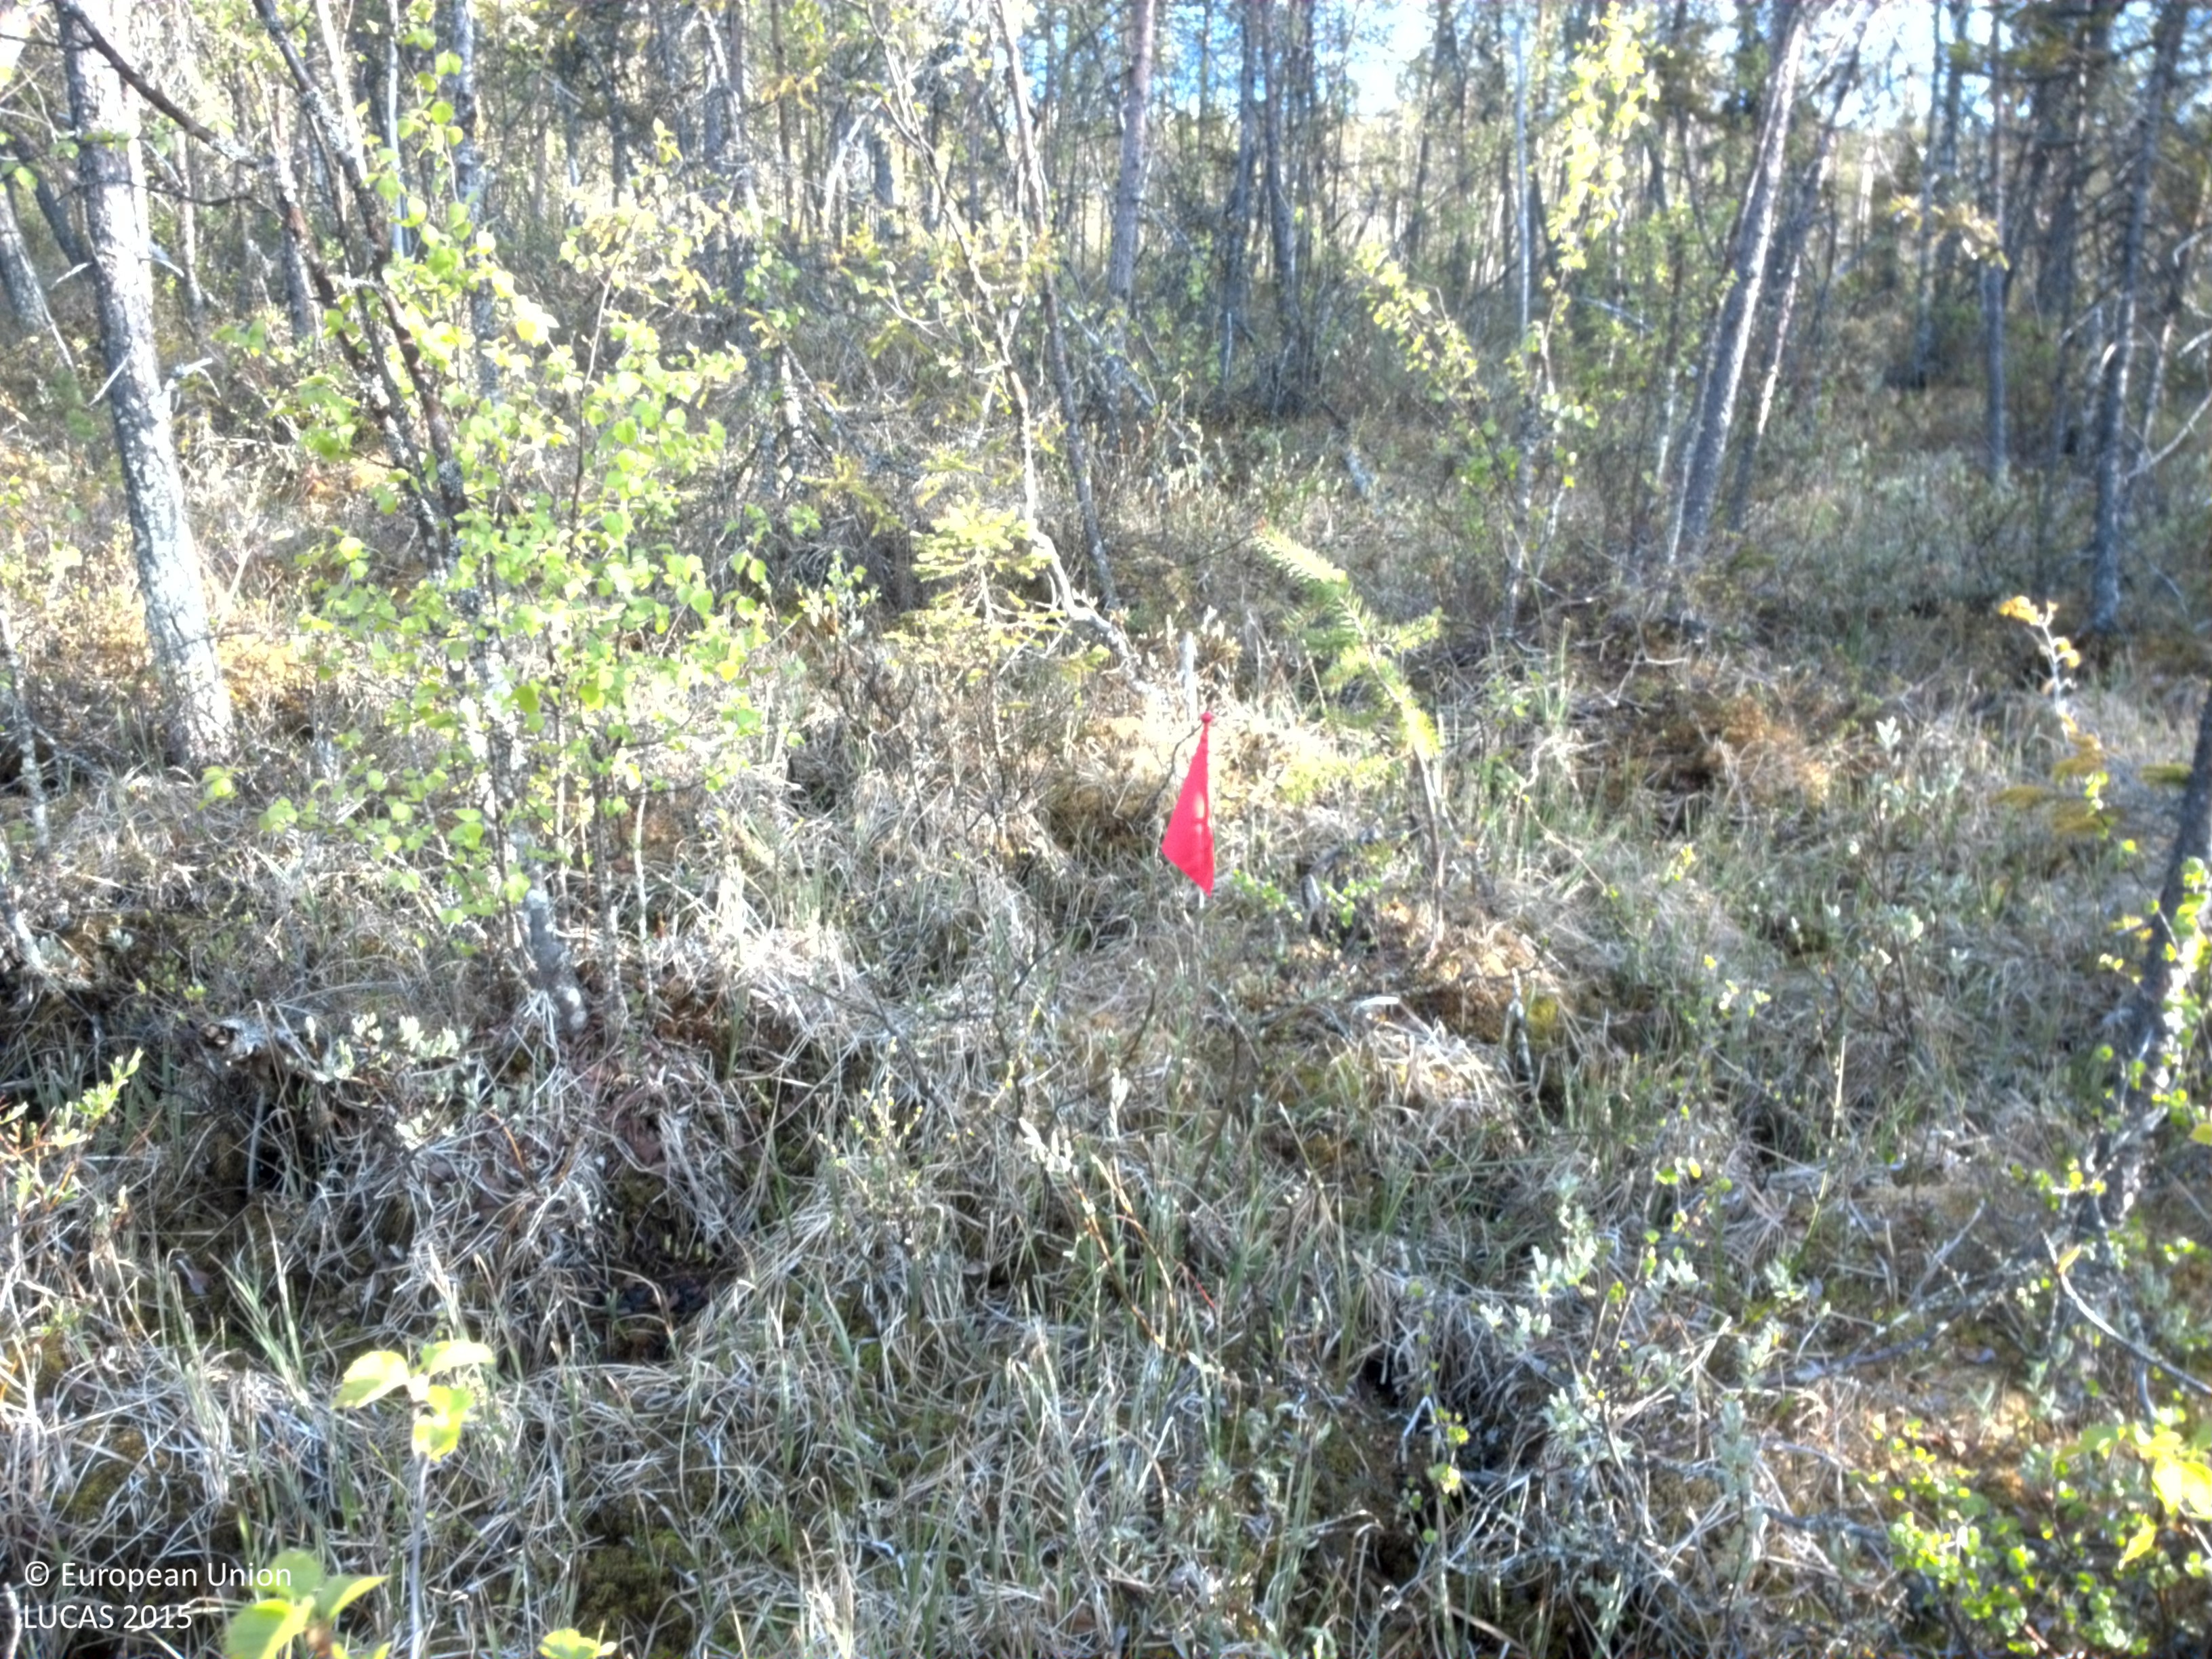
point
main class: Woodland
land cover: Pine dominated mixed woodland
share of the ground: 10 - 25 %
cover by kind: shrubs 50 %, herbaceous plants 20 %, coniferous forest trees 15 %, lichens and mosses 10 %, broadleaved forest trees 5 %
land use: Semi-natural and natural areas not in use
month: June
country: SE
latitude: 66.8826
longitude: 21.6220
